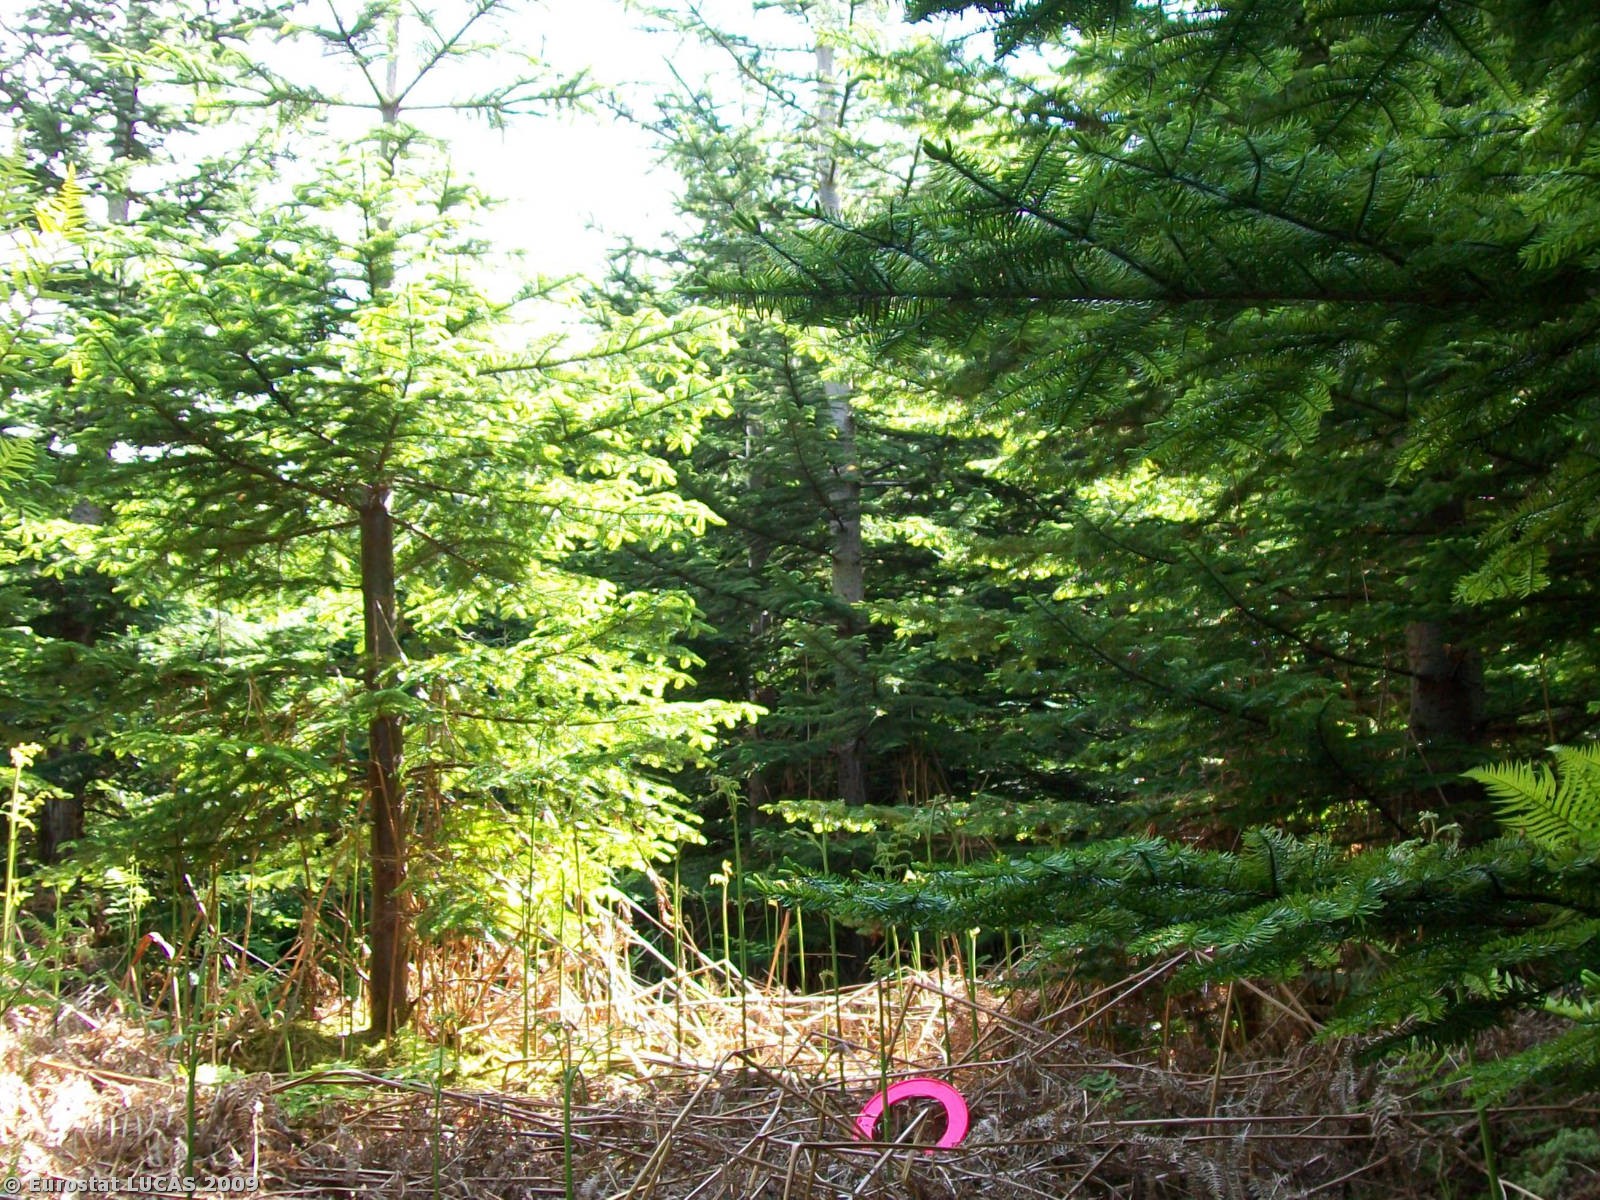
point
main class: Woodland
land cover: Coniferous woodland
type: plantations and self-sown exotic forest
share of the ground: 50 - 75 %
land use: Forestry
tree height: > 5 m
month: June
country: GB
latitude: 56.5048
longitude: -5.3398
